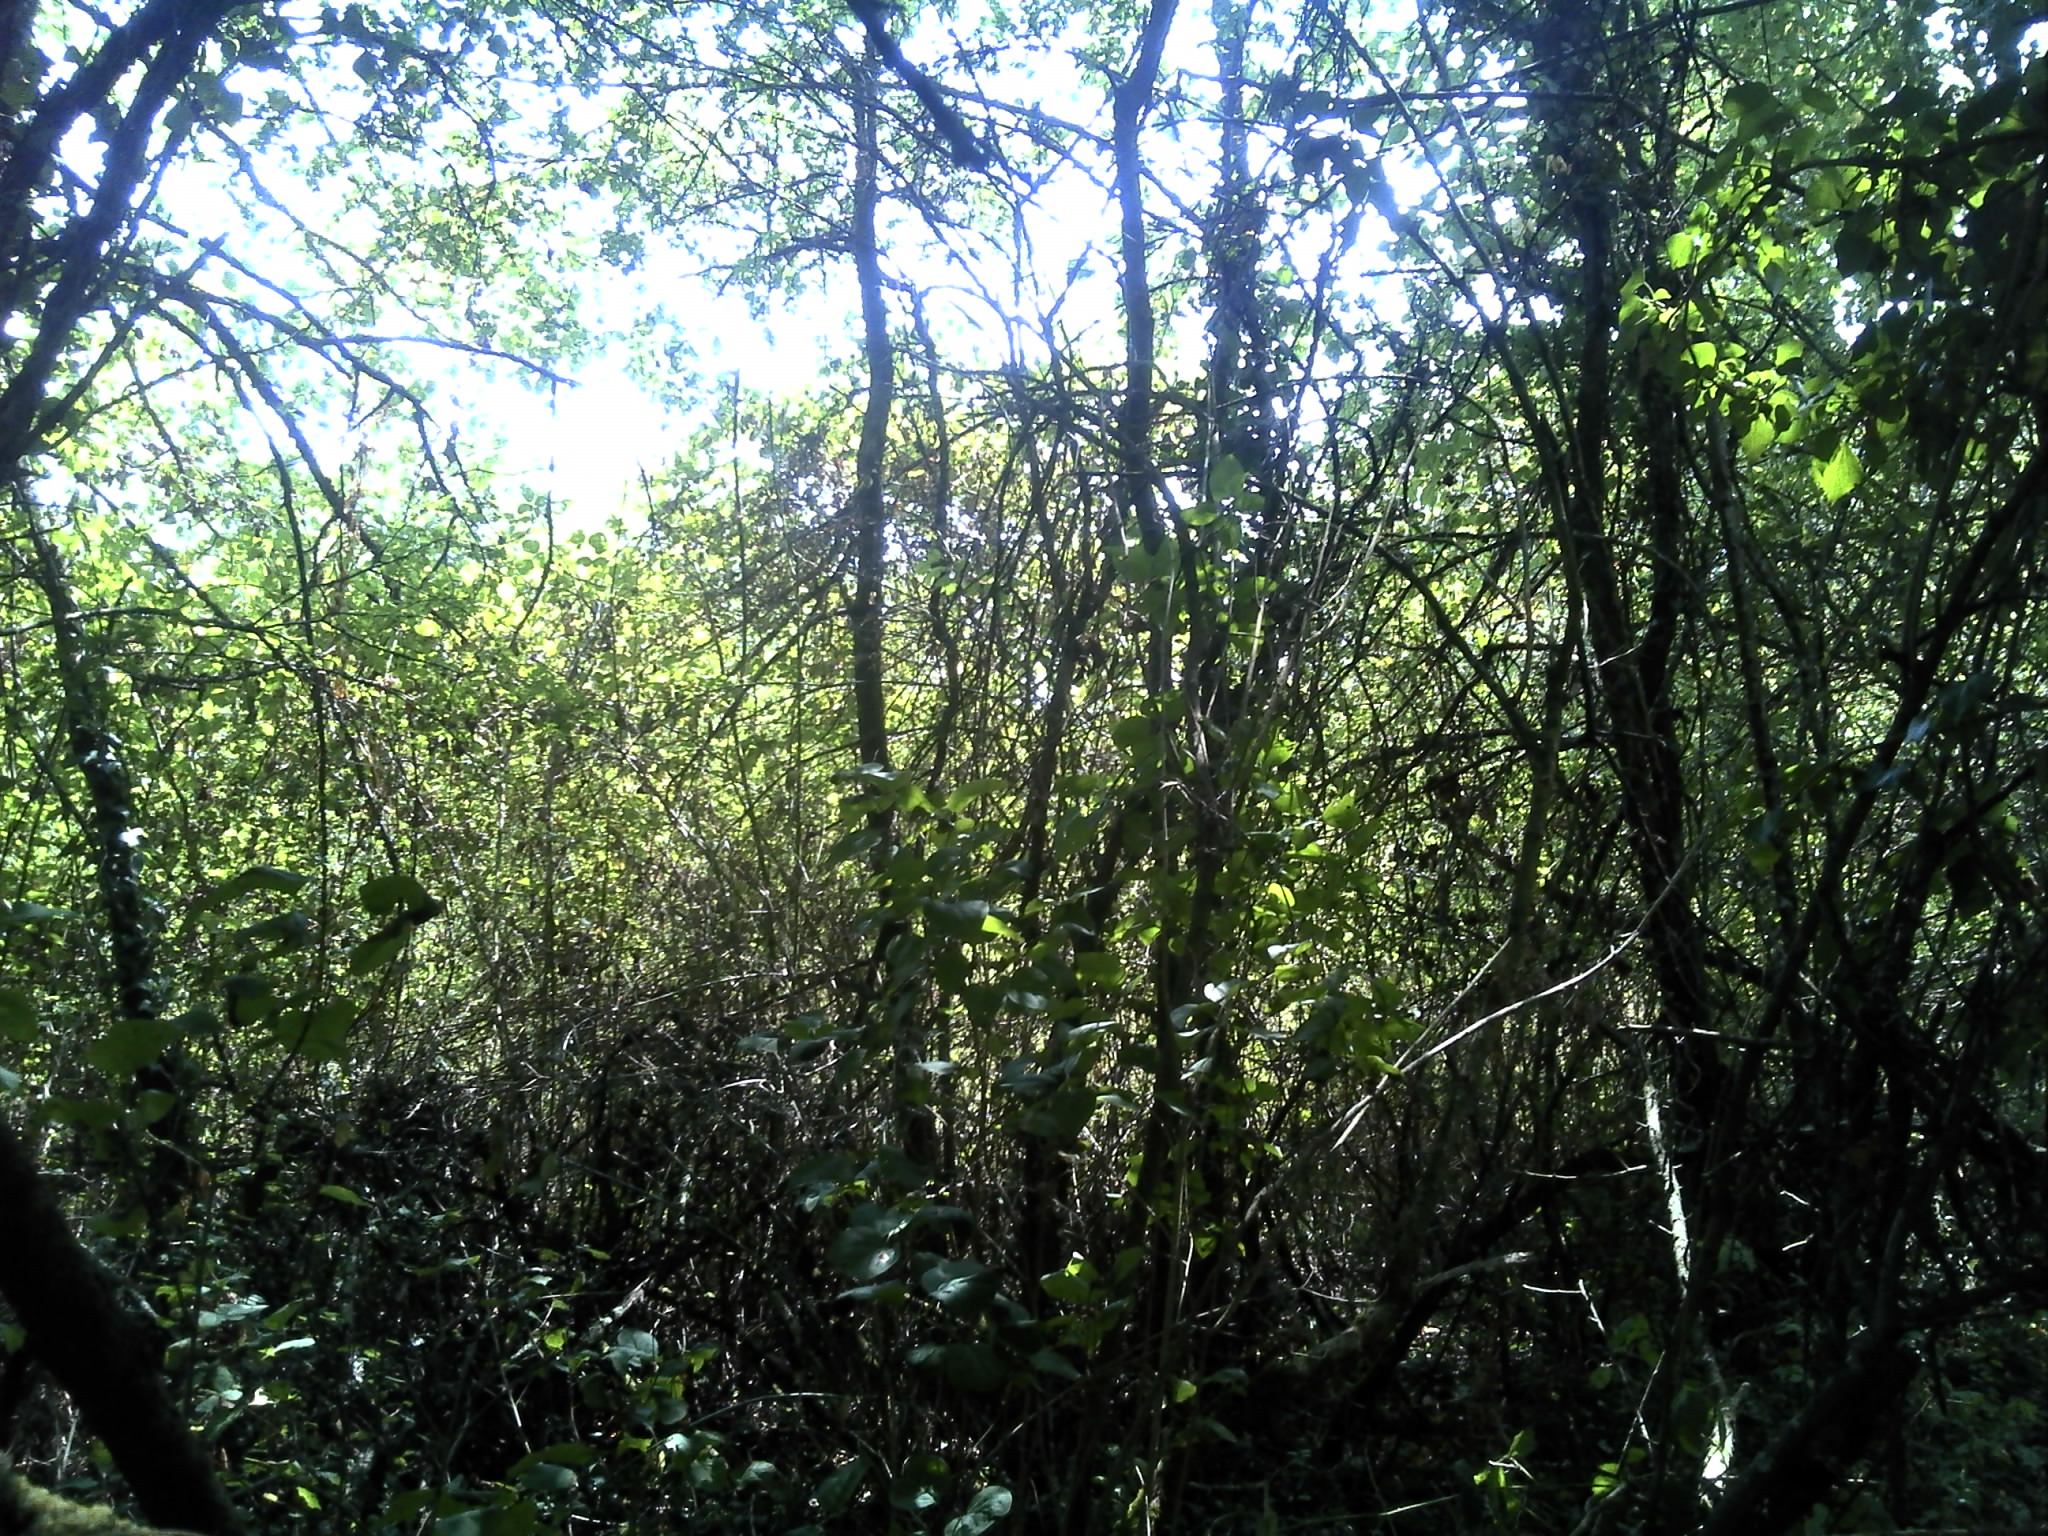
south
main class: Woodland
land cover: Broadleaved woodland
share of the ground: > 75 %
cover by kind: broadleaved forest trees 80 %, shrubs 15 %, herbaceous plants 5 %
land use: Semi-natural and natural areas not in use
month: August
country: FR
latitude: 46.5339
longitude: 1.6853
